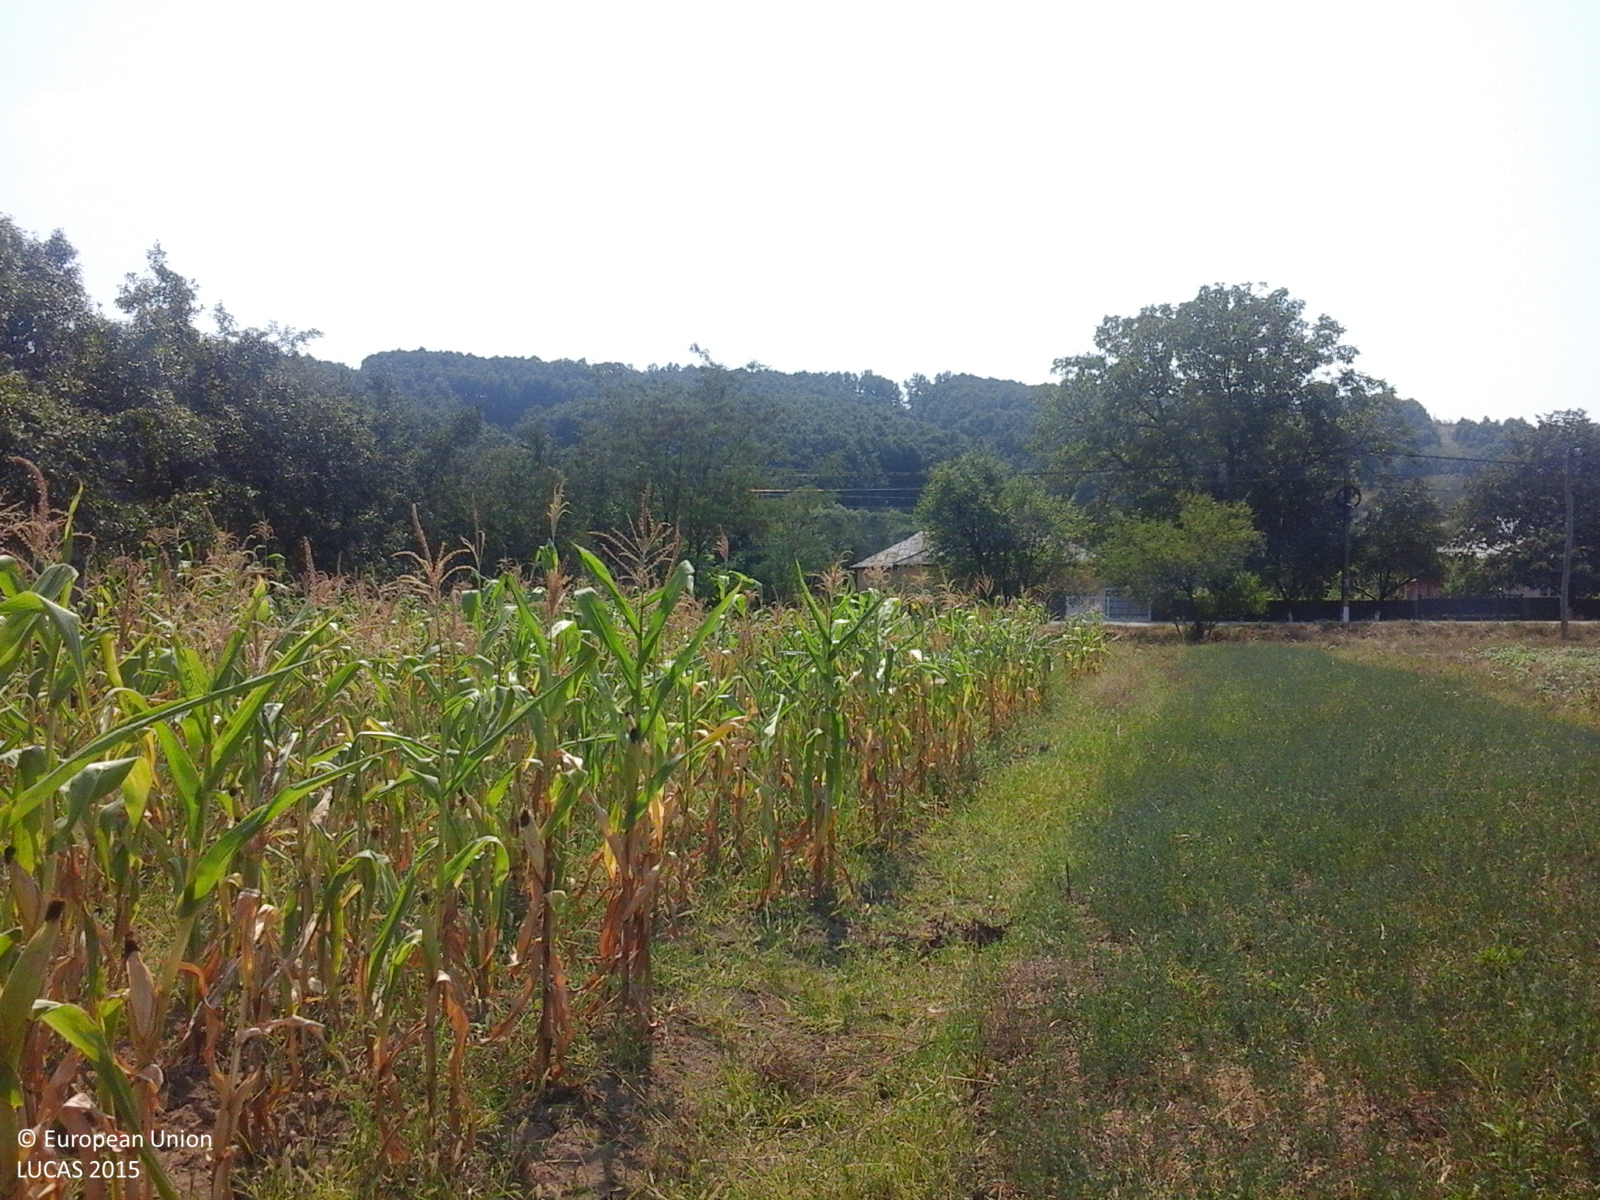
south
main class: Cropland
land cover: Lucerne
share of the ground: > 75 %
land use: Agriculture (excluding fallow land and kitchen gardens)
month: August
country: RO
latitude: 44.6357
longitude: 23.8901
